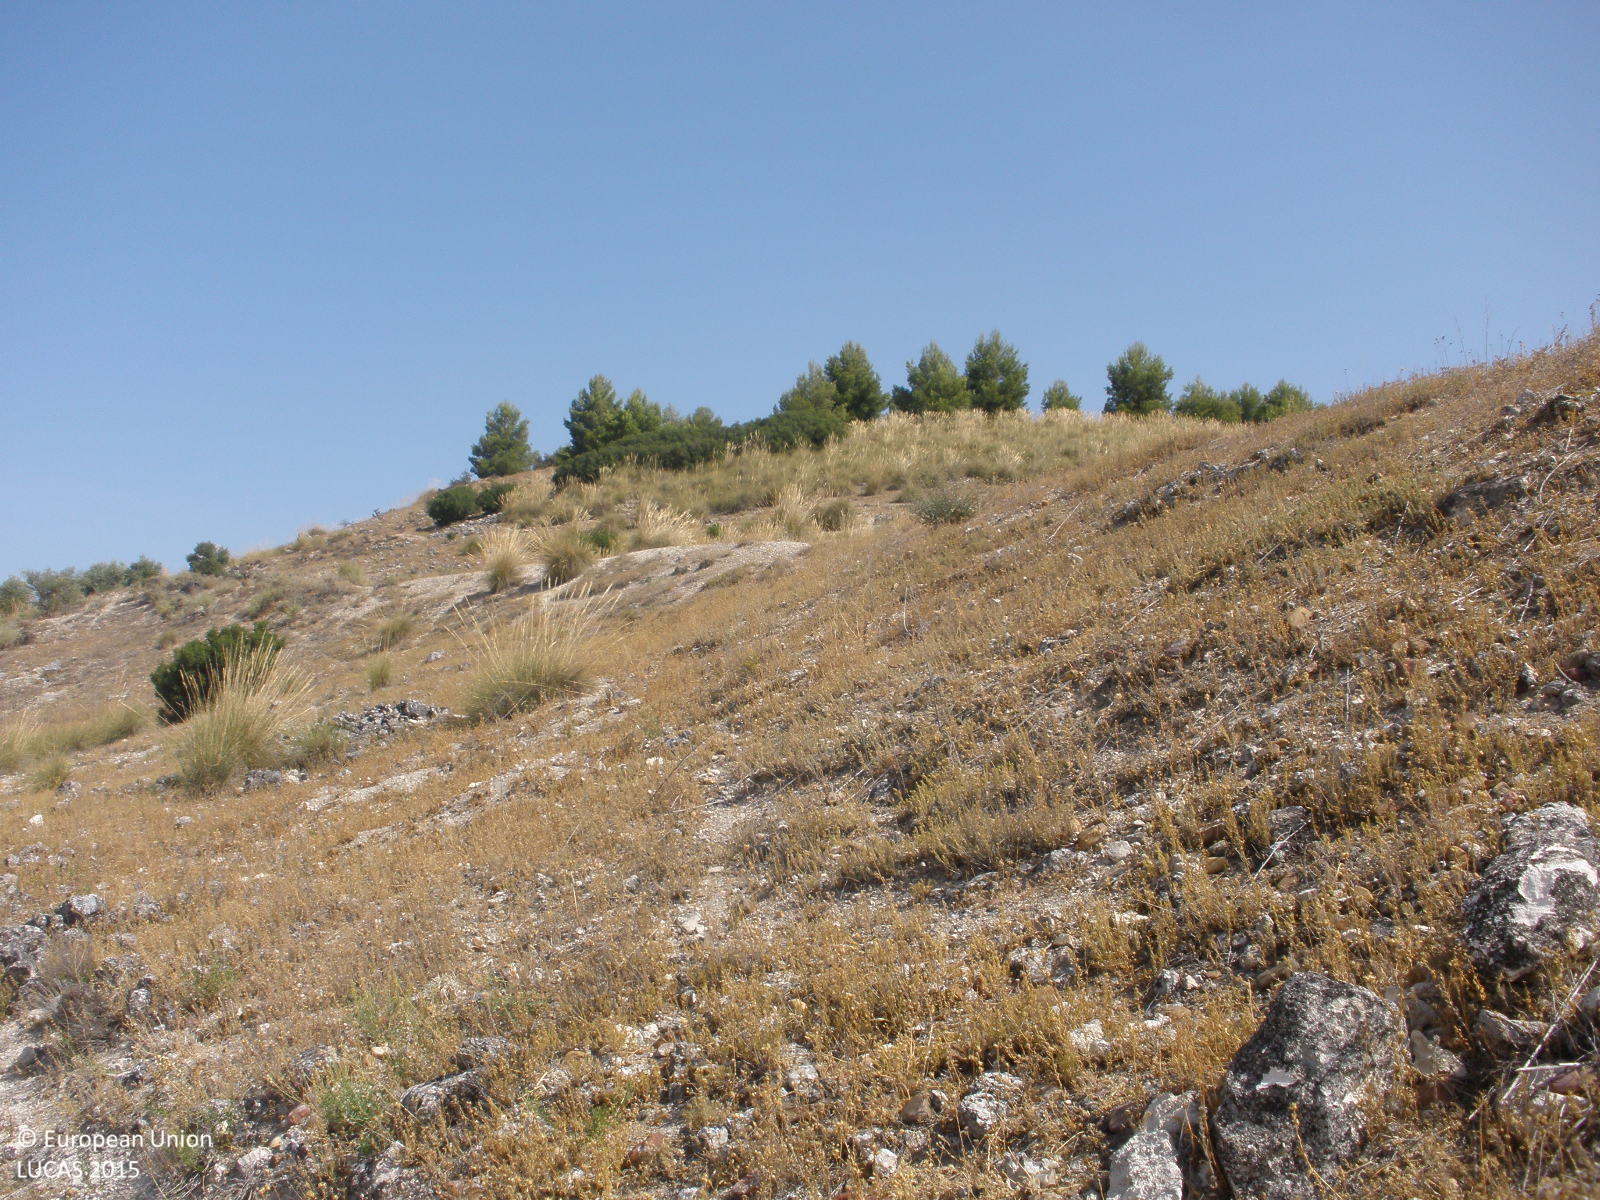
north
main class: Shrubland
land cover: Shrubland without tree cover
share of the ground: 10 - 25 %
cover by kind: herbaceous plants 60 %, shrubs 20 %, consolidated bare surface 20 %
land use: Semi-natural and natural areas not in use
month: July
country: ES
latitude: 40.2882
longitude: -3.4541
